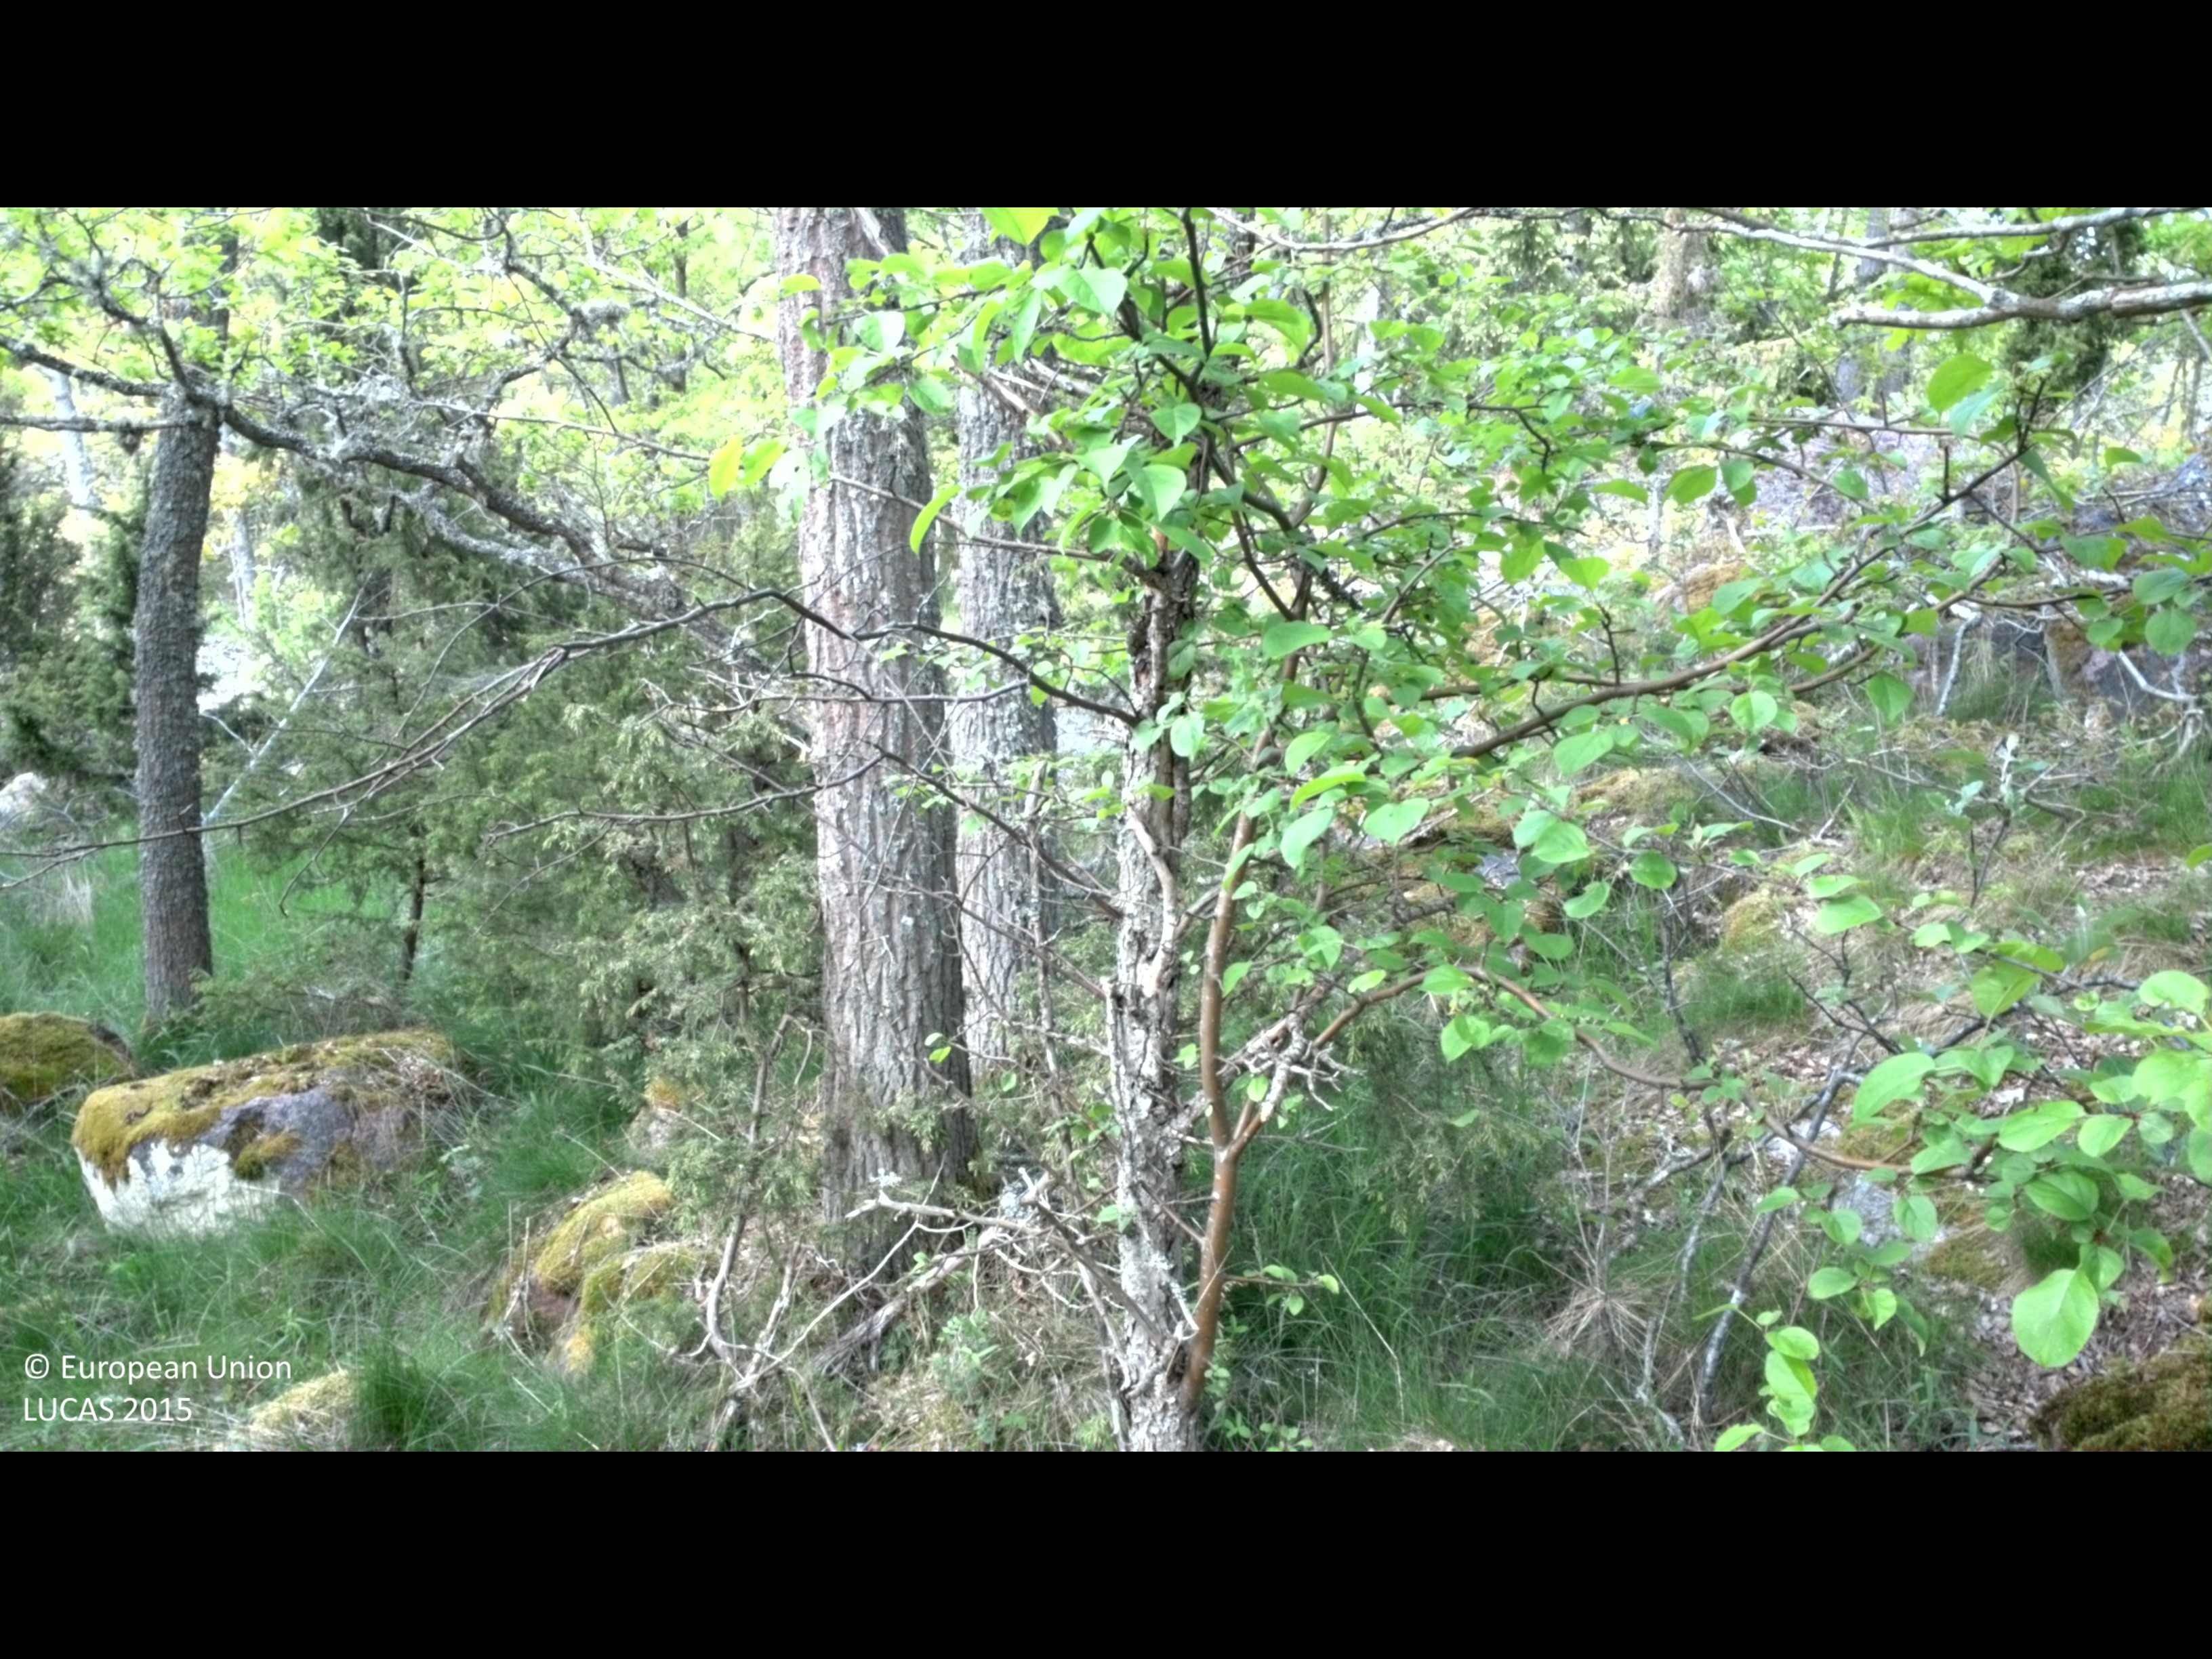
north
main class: Woodland
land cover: Broadleaved woodland
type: mesophytic deciduous forest
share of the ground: > 75 %
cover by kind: broadleaved forest trees 90 %, shrubs 5 %, herbaceous plants 5 %
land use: Forestry
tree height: > 5 m
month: May
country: SE
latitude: 57.1436
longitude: 16.4619
